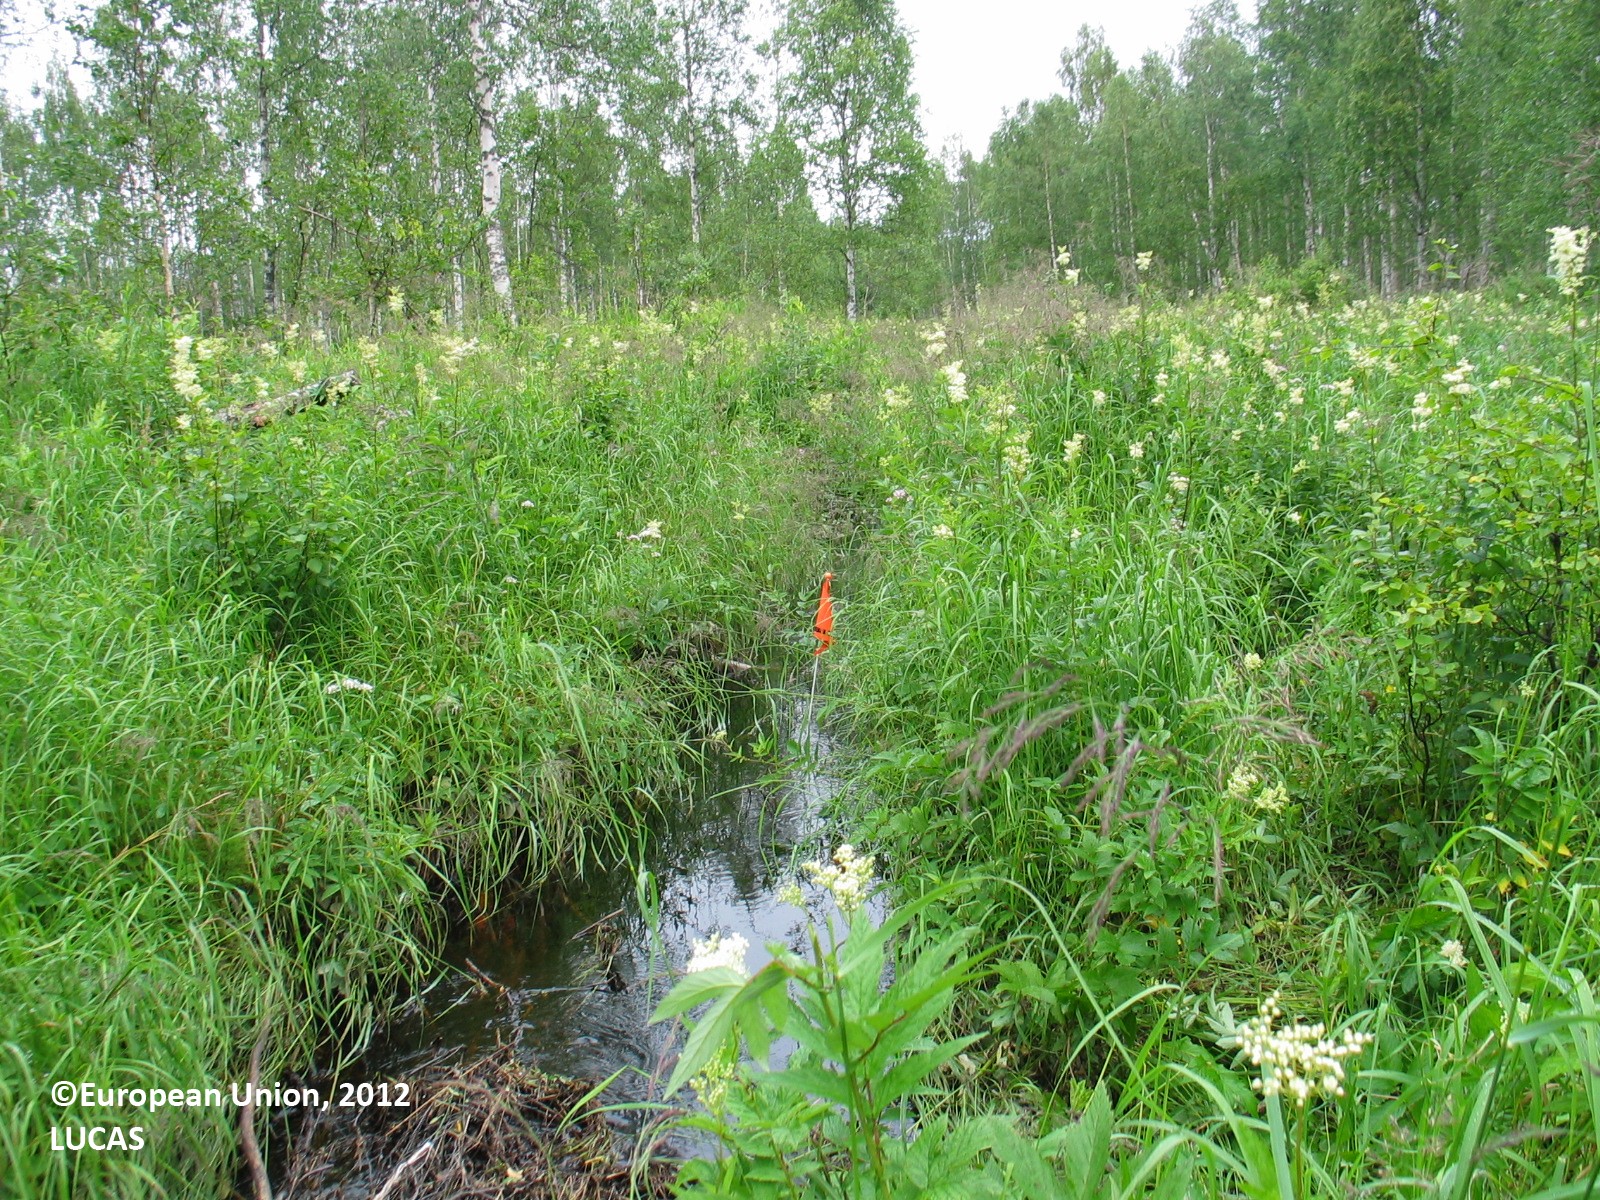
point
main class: Grassland
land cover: Spontaneously vegetated surfaces
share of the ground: > 75 %
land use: Forestry
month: July
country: FI
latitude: 65.8511
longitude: 25.2929
